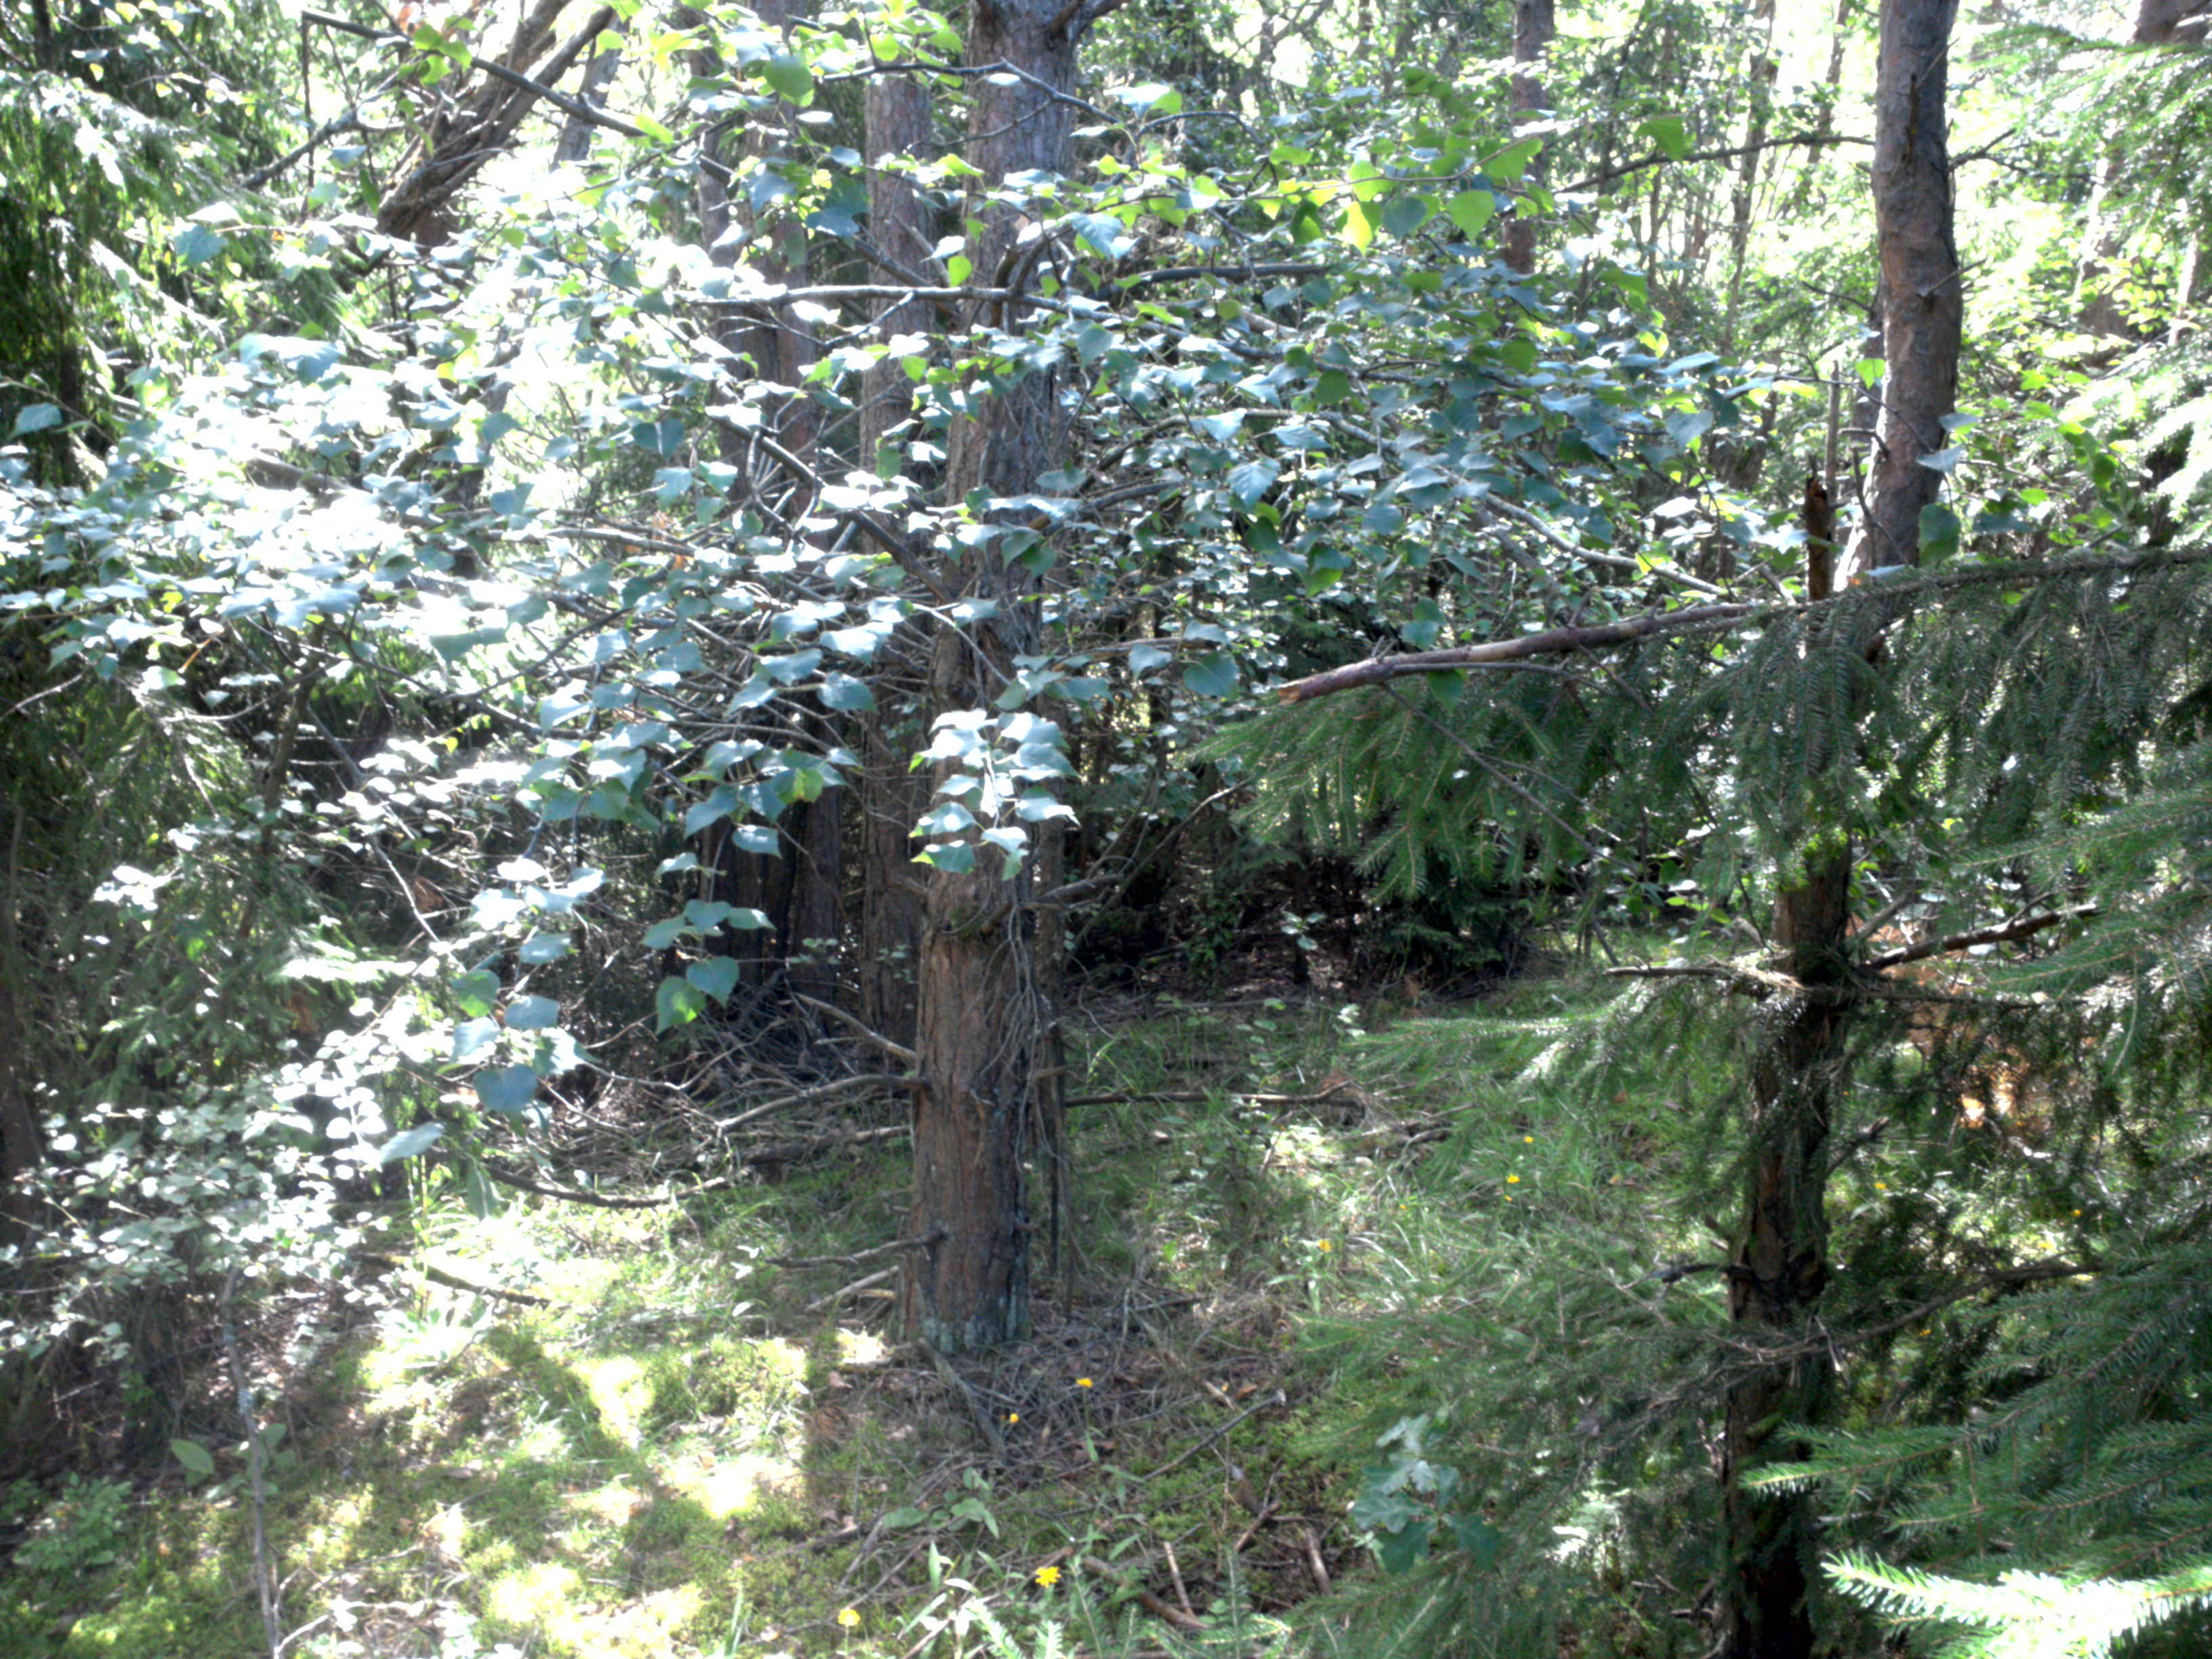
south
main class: Woodland
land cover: Pine dominated coniferous woodland
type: boreal forest
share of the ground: > 75 %
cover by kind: coniferous forest trees 75 %, lichens and mosses 20 %, broadleaved forest trees 5 %
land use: Forestry
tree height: > 5 m
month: August
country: SE
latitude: 59.1236
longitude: 17.6320
